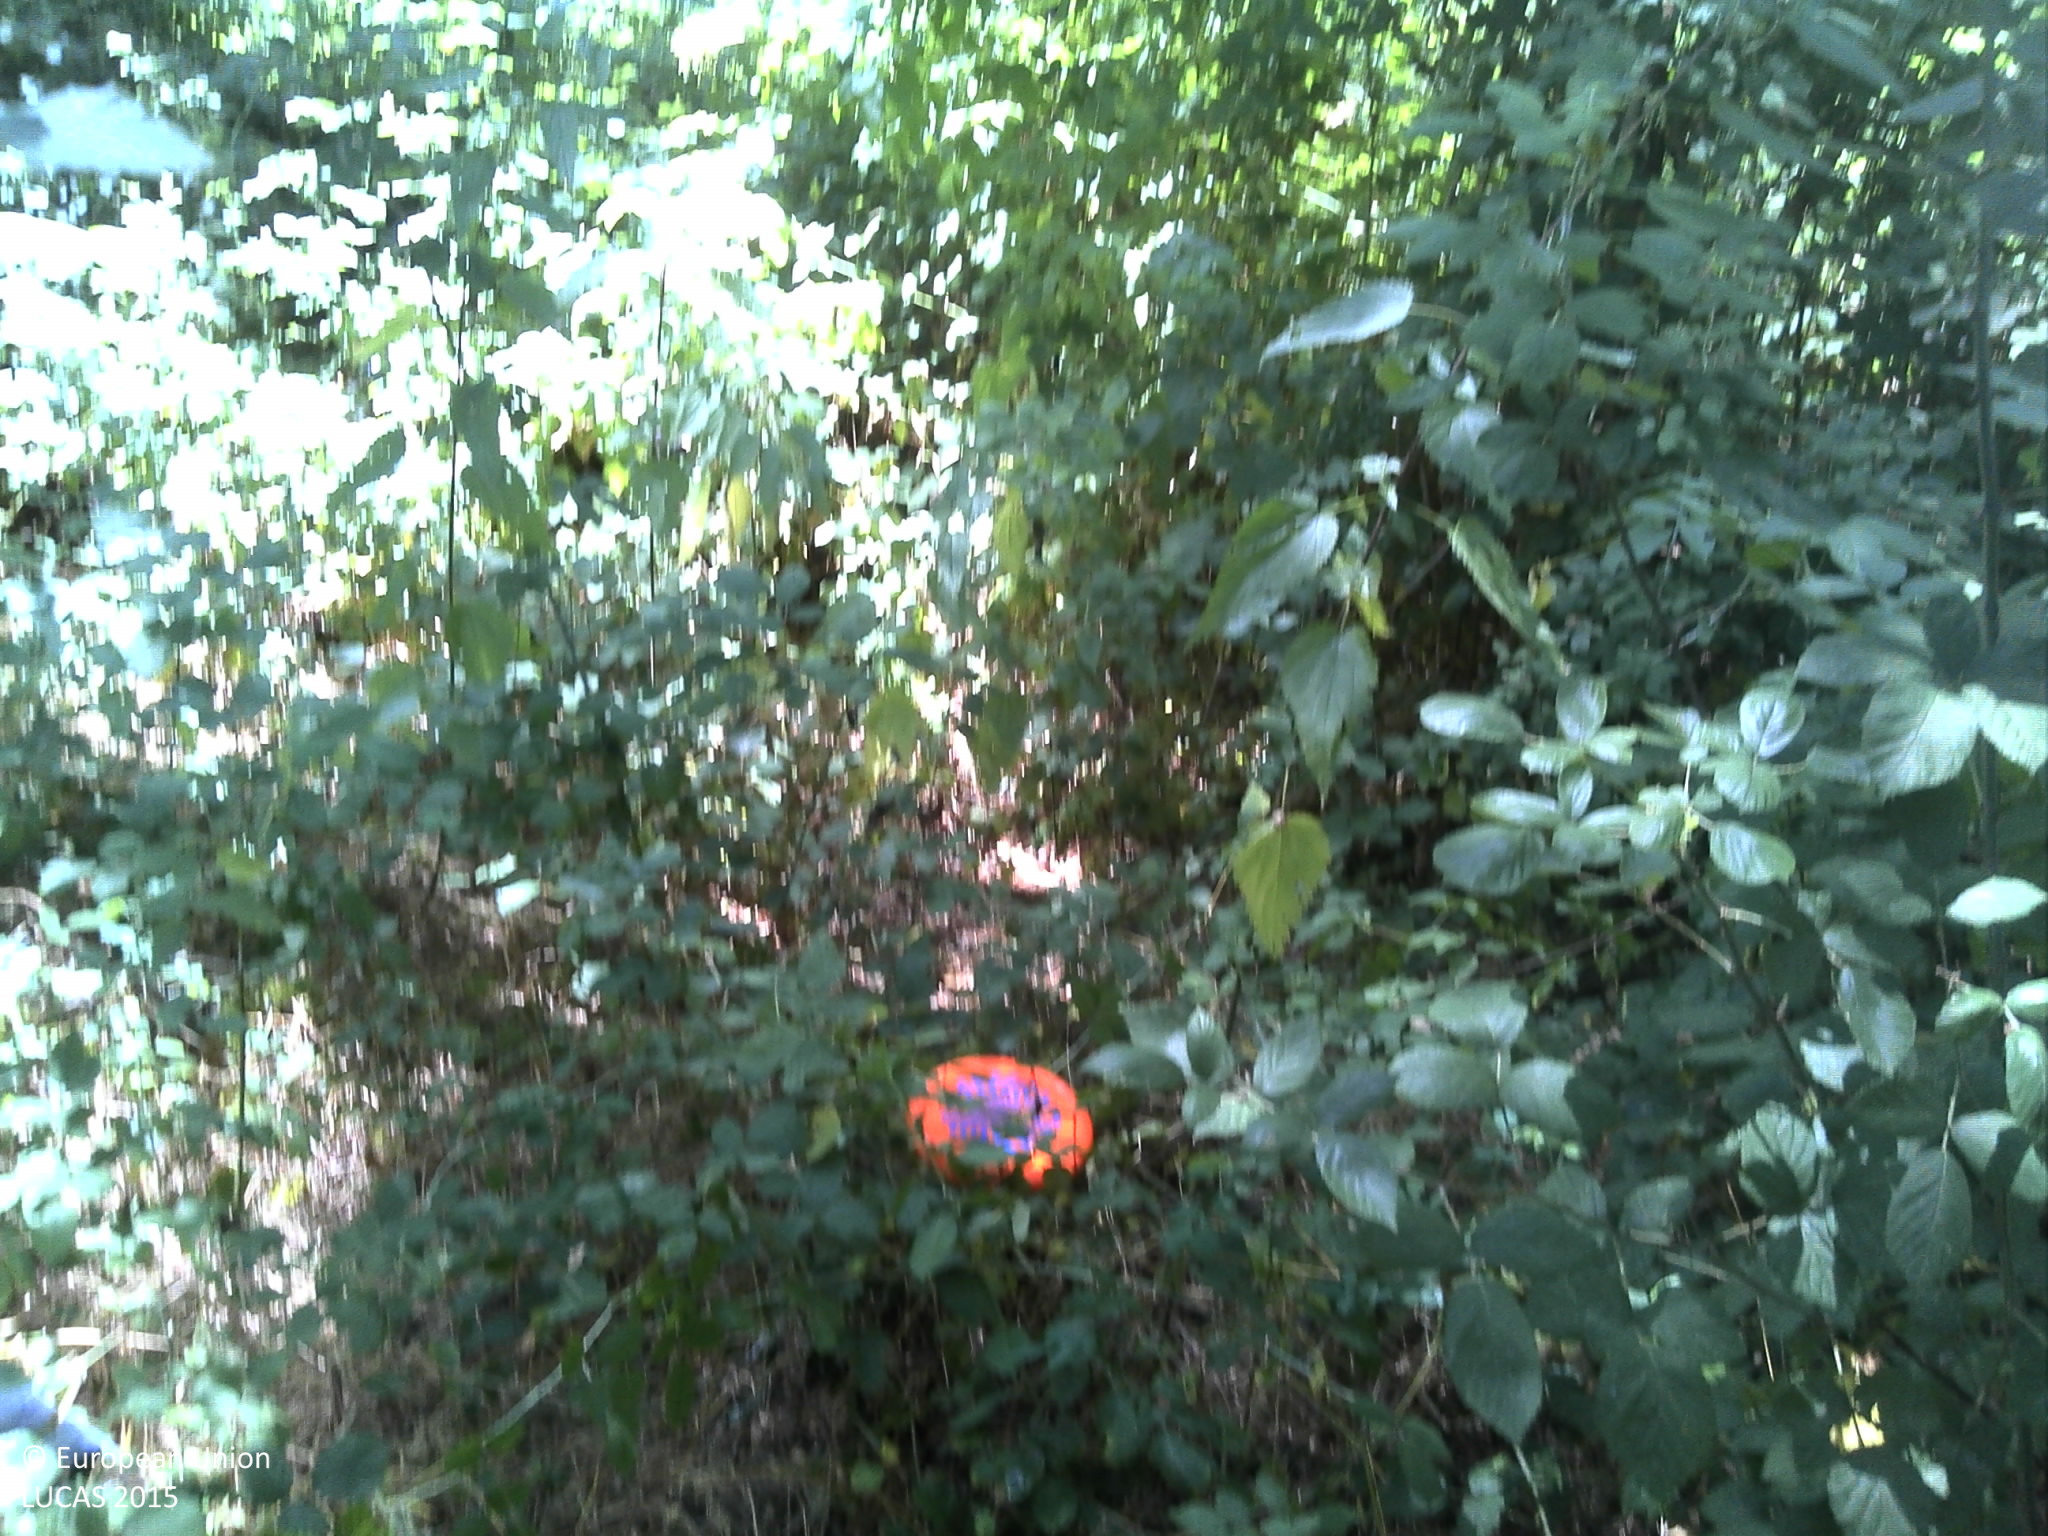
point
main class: Woodland
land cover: Broadleaved woodland
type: floodplain forest
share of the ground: > 75 %
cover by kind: broadleaved forest trees 70 %, shrubs 20 %, herbaceous plants 5 %, lichens and mosses 5 %
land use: Forestry
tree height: > 5 m
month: July
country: FR
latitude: 44.4132
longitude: -0.3494
